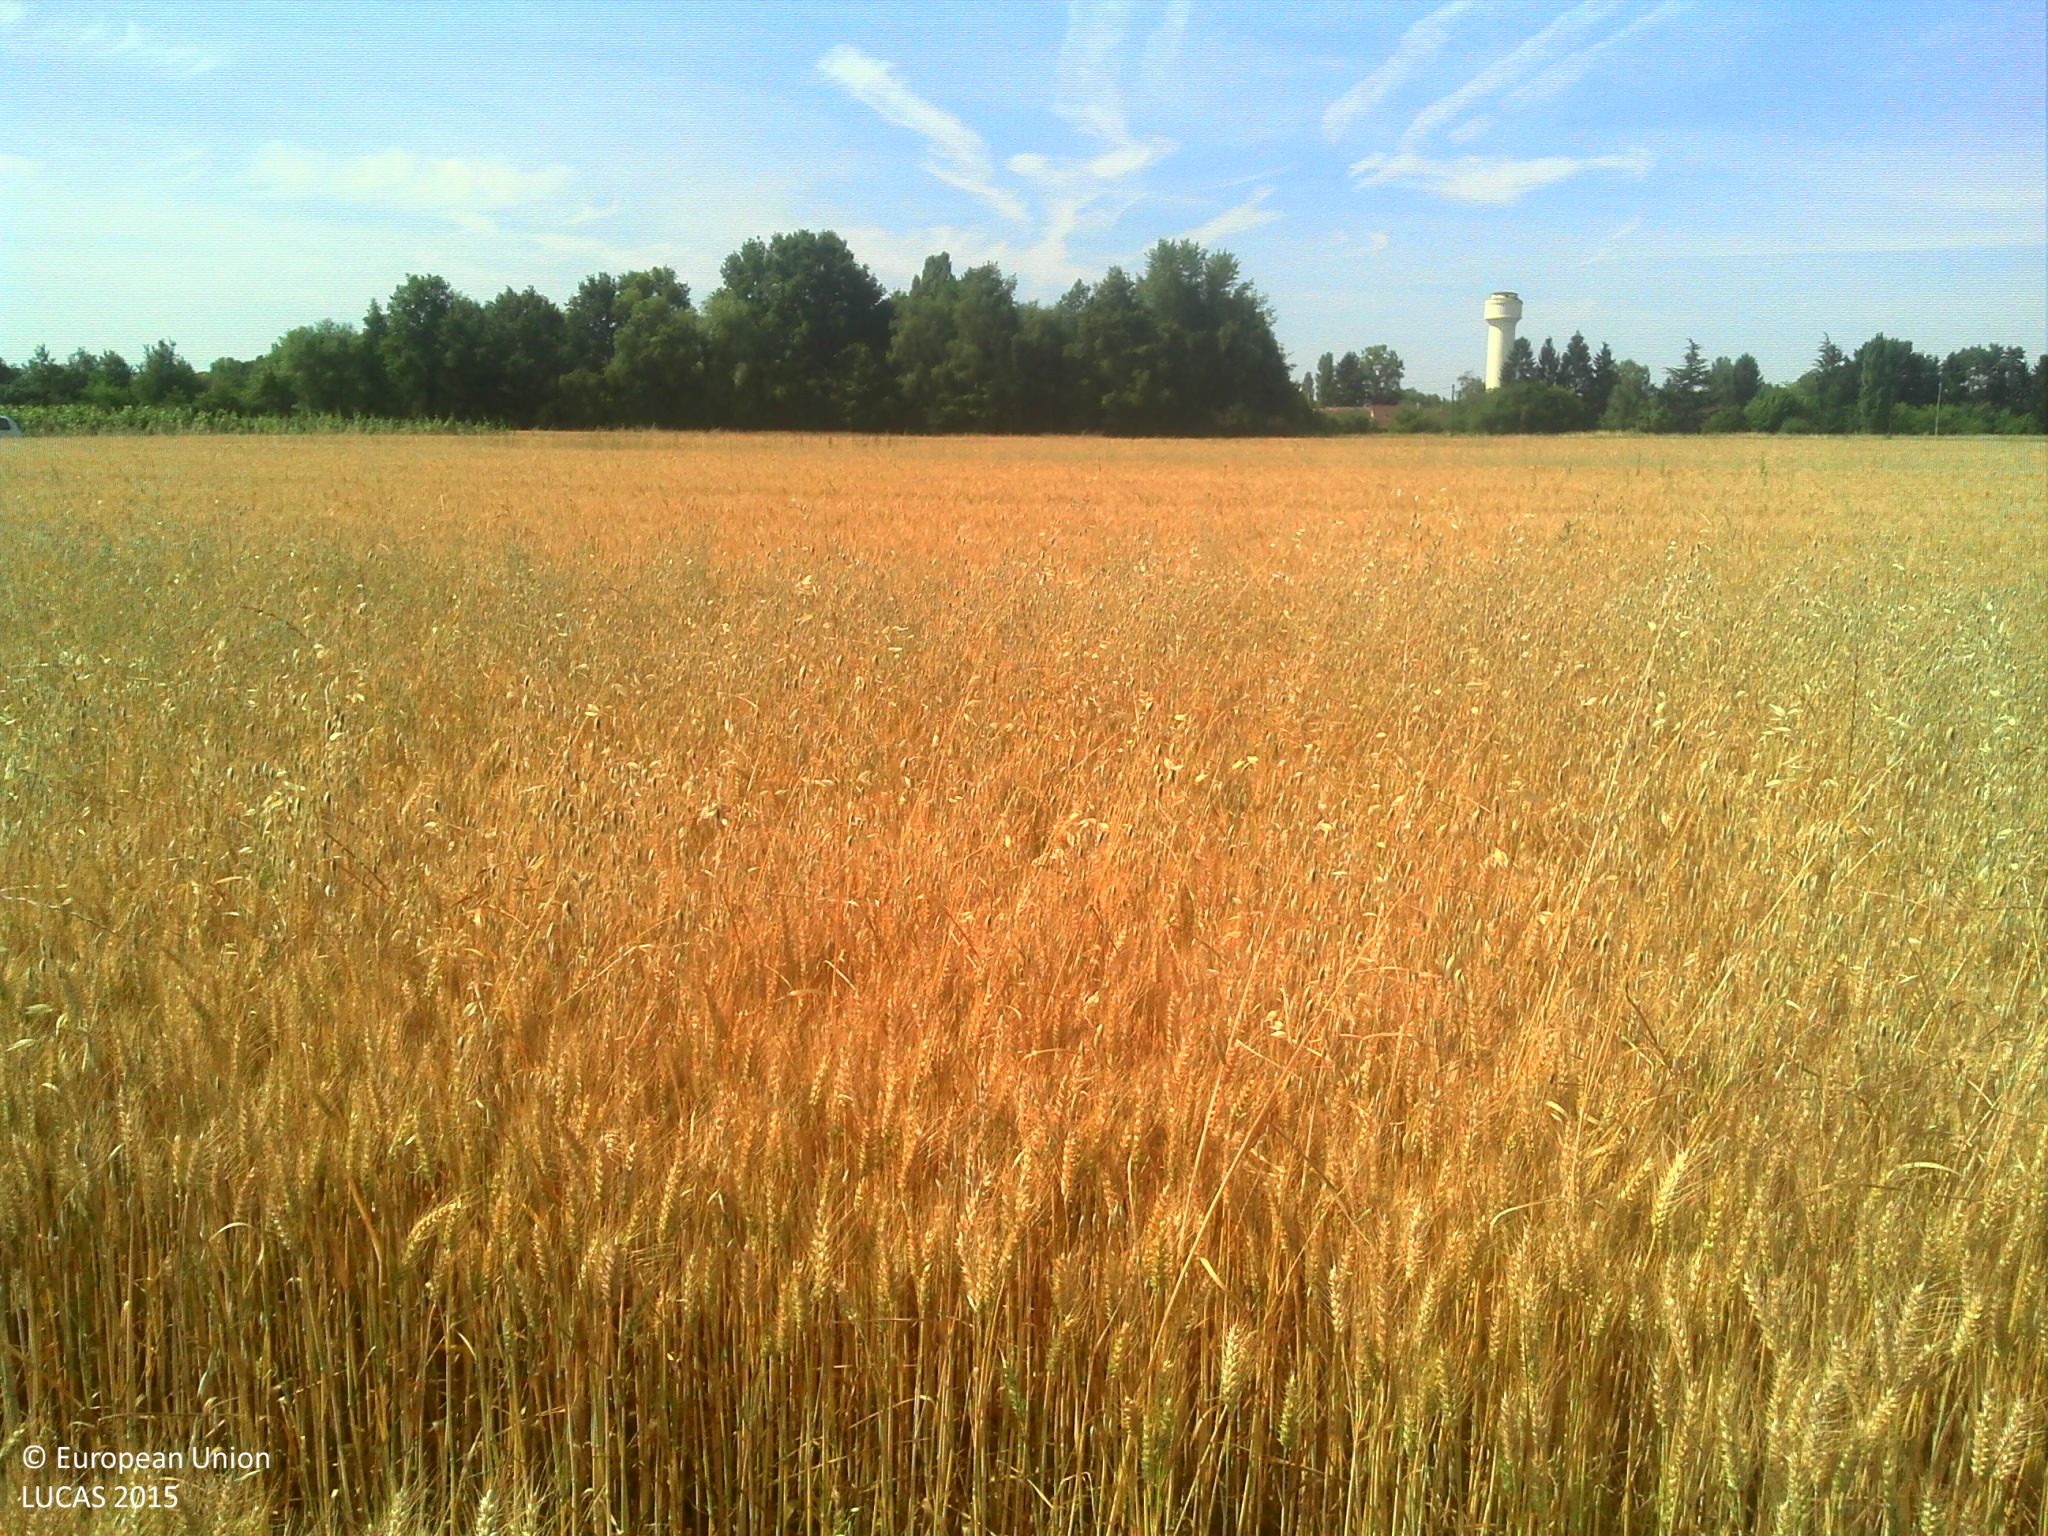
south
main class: Cropland
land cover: Common wheat
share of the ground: > 75 %
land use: Agriculture (excluding fallow land and kitchen gardens)
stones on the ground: < 10 %
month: June
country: FR
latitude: 47.5066
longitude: 1.3953
